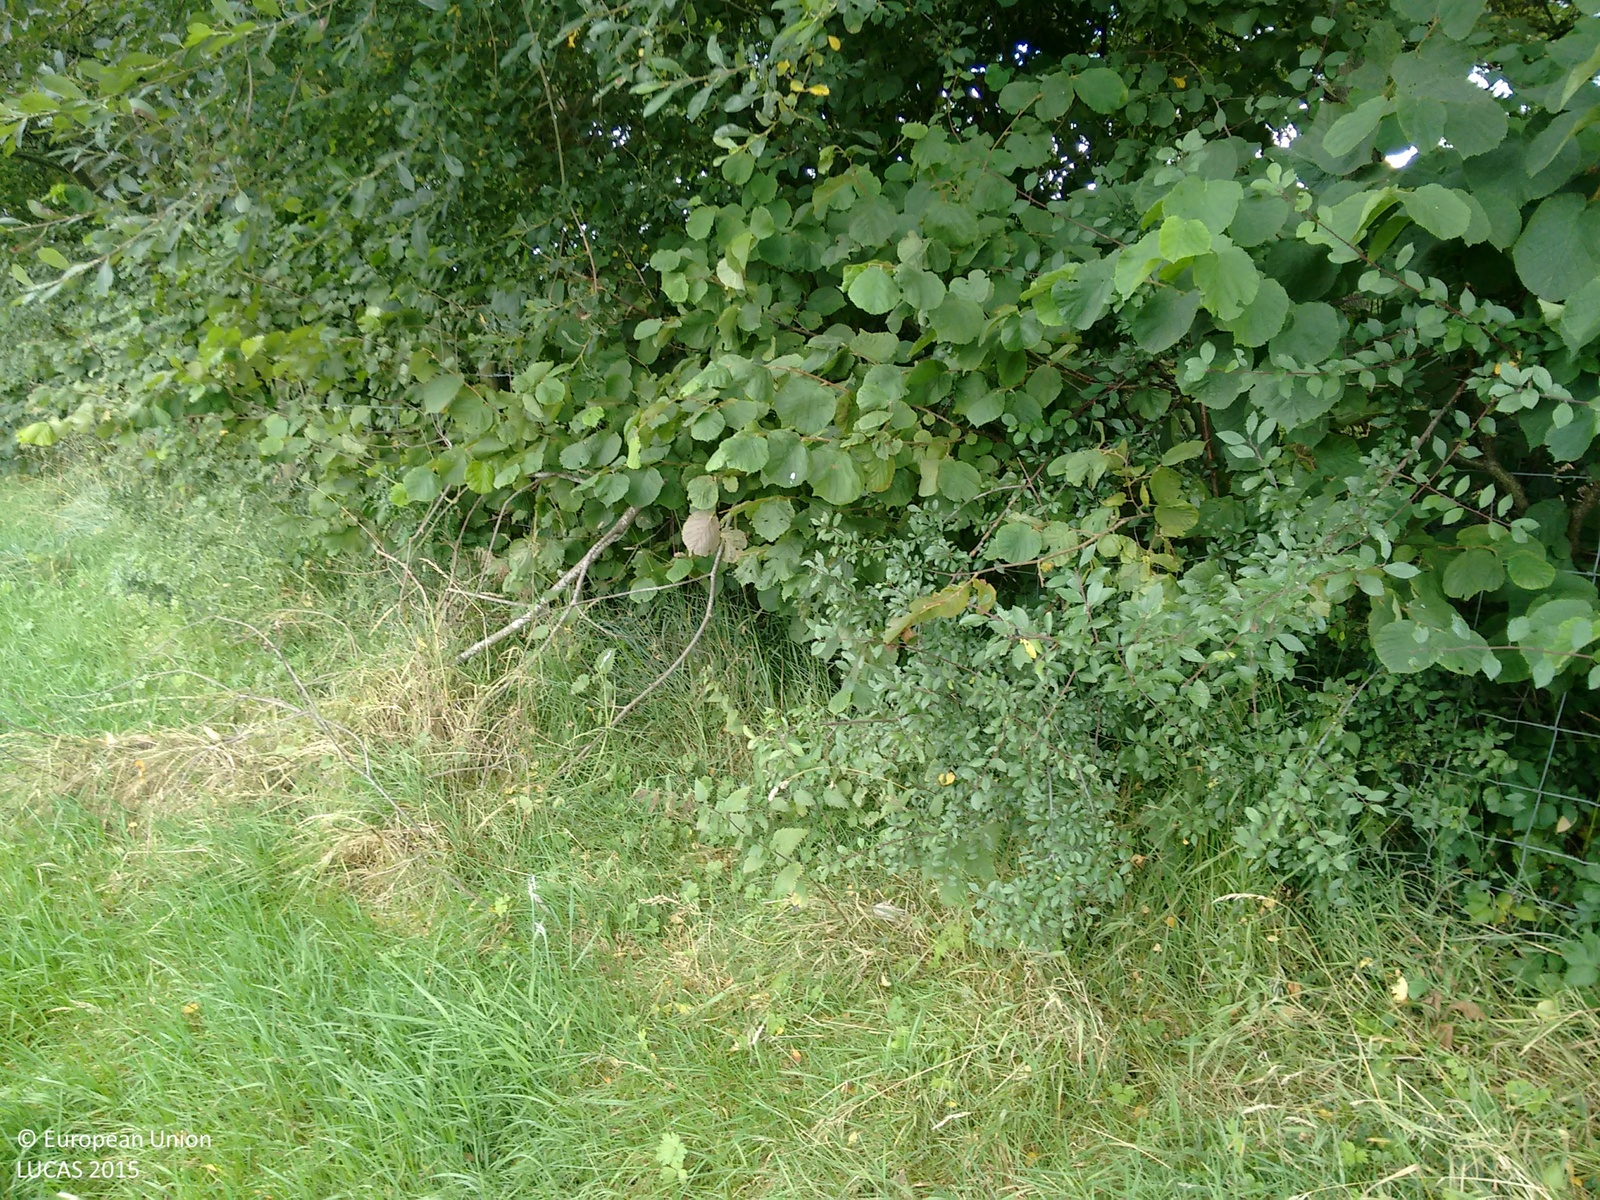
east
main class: Grassland
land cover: Grassland without tree/shrub cover
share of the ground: > 75 %
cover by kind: herbaceous plants 100 %
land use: Agriculture (excluding fallow land and kitchen gardens)
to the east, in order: Grassland without tree/shrub cover; Fences; Broadleaved woodland; Tracks; Grass margins; Fences; Broadleaved woodland; Grassland without tree/shrub cover; Managed hedges; Grassland without tree/shrub cover
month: September
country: GB
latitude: 54.5348
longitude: -2.5047
